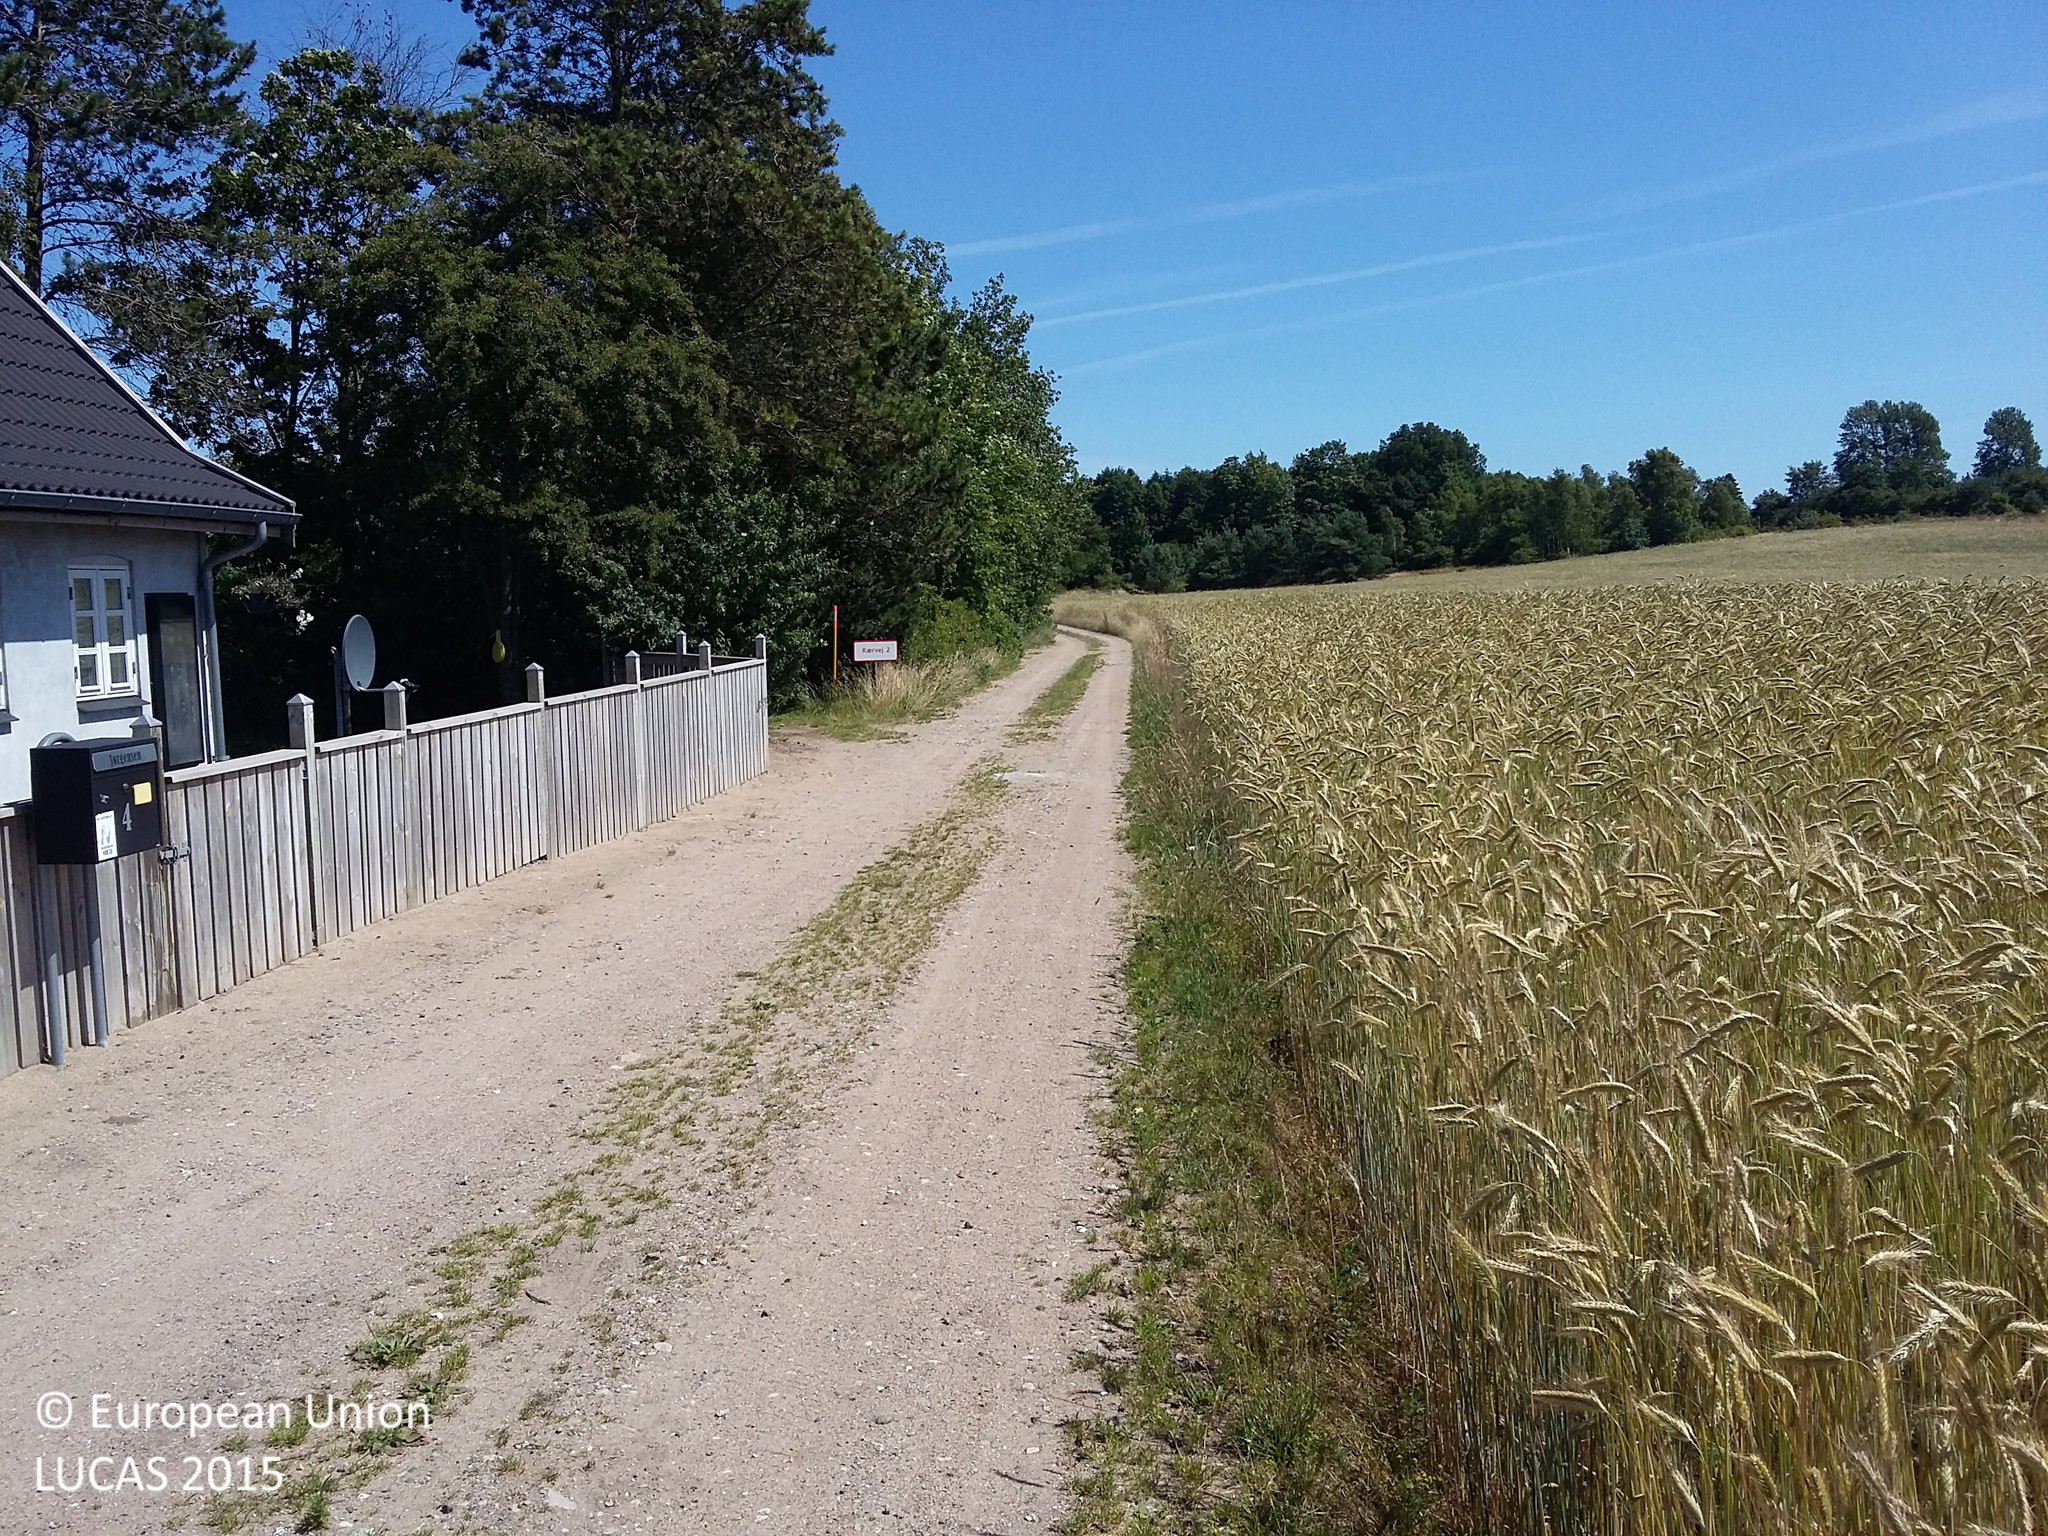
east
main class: Cropland
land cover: Rye
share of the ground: > 75 %
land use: Agriculture (excluding fallow land and kitchen gardens)
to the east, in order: Rye; Spruce dominated coniferous woodland; Broadleaved woodland
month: July
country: DK
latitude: 55.5677
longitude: 11.5051
